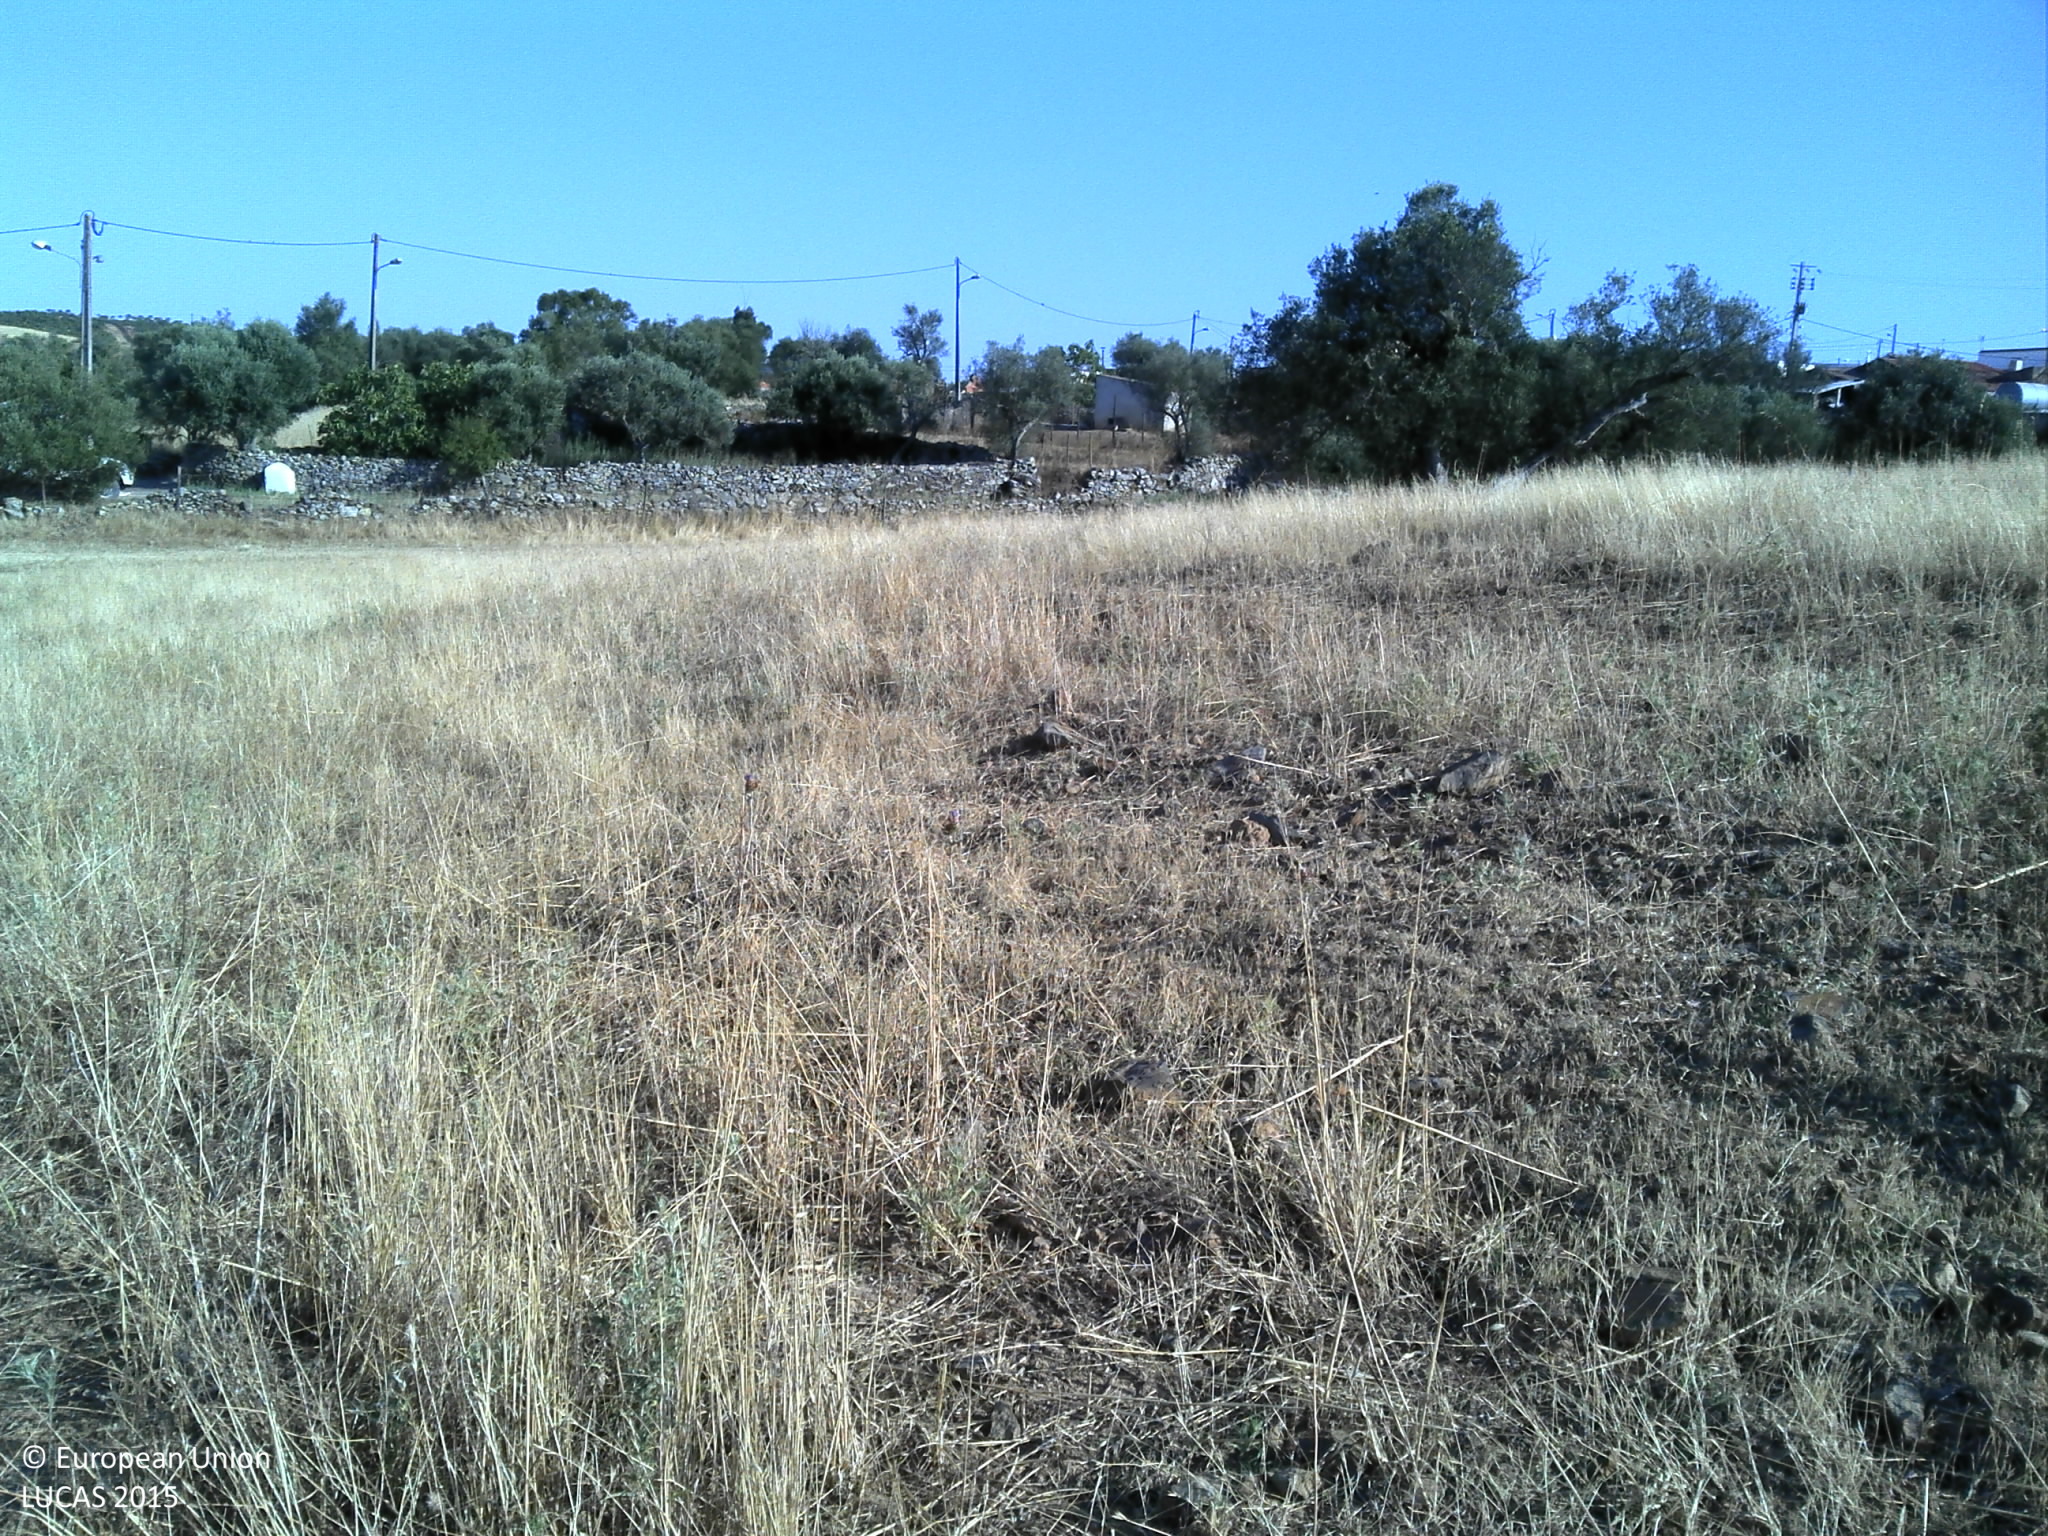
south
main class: Grassland
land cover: Grassland without tree/shrub cover
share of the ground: > 75 %
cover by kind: herbaceous plants 100 %
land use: Agriculture (excluding fallow land and kitchen gardens)
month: June
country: PT
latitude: 37.4611
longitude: -7.8913
